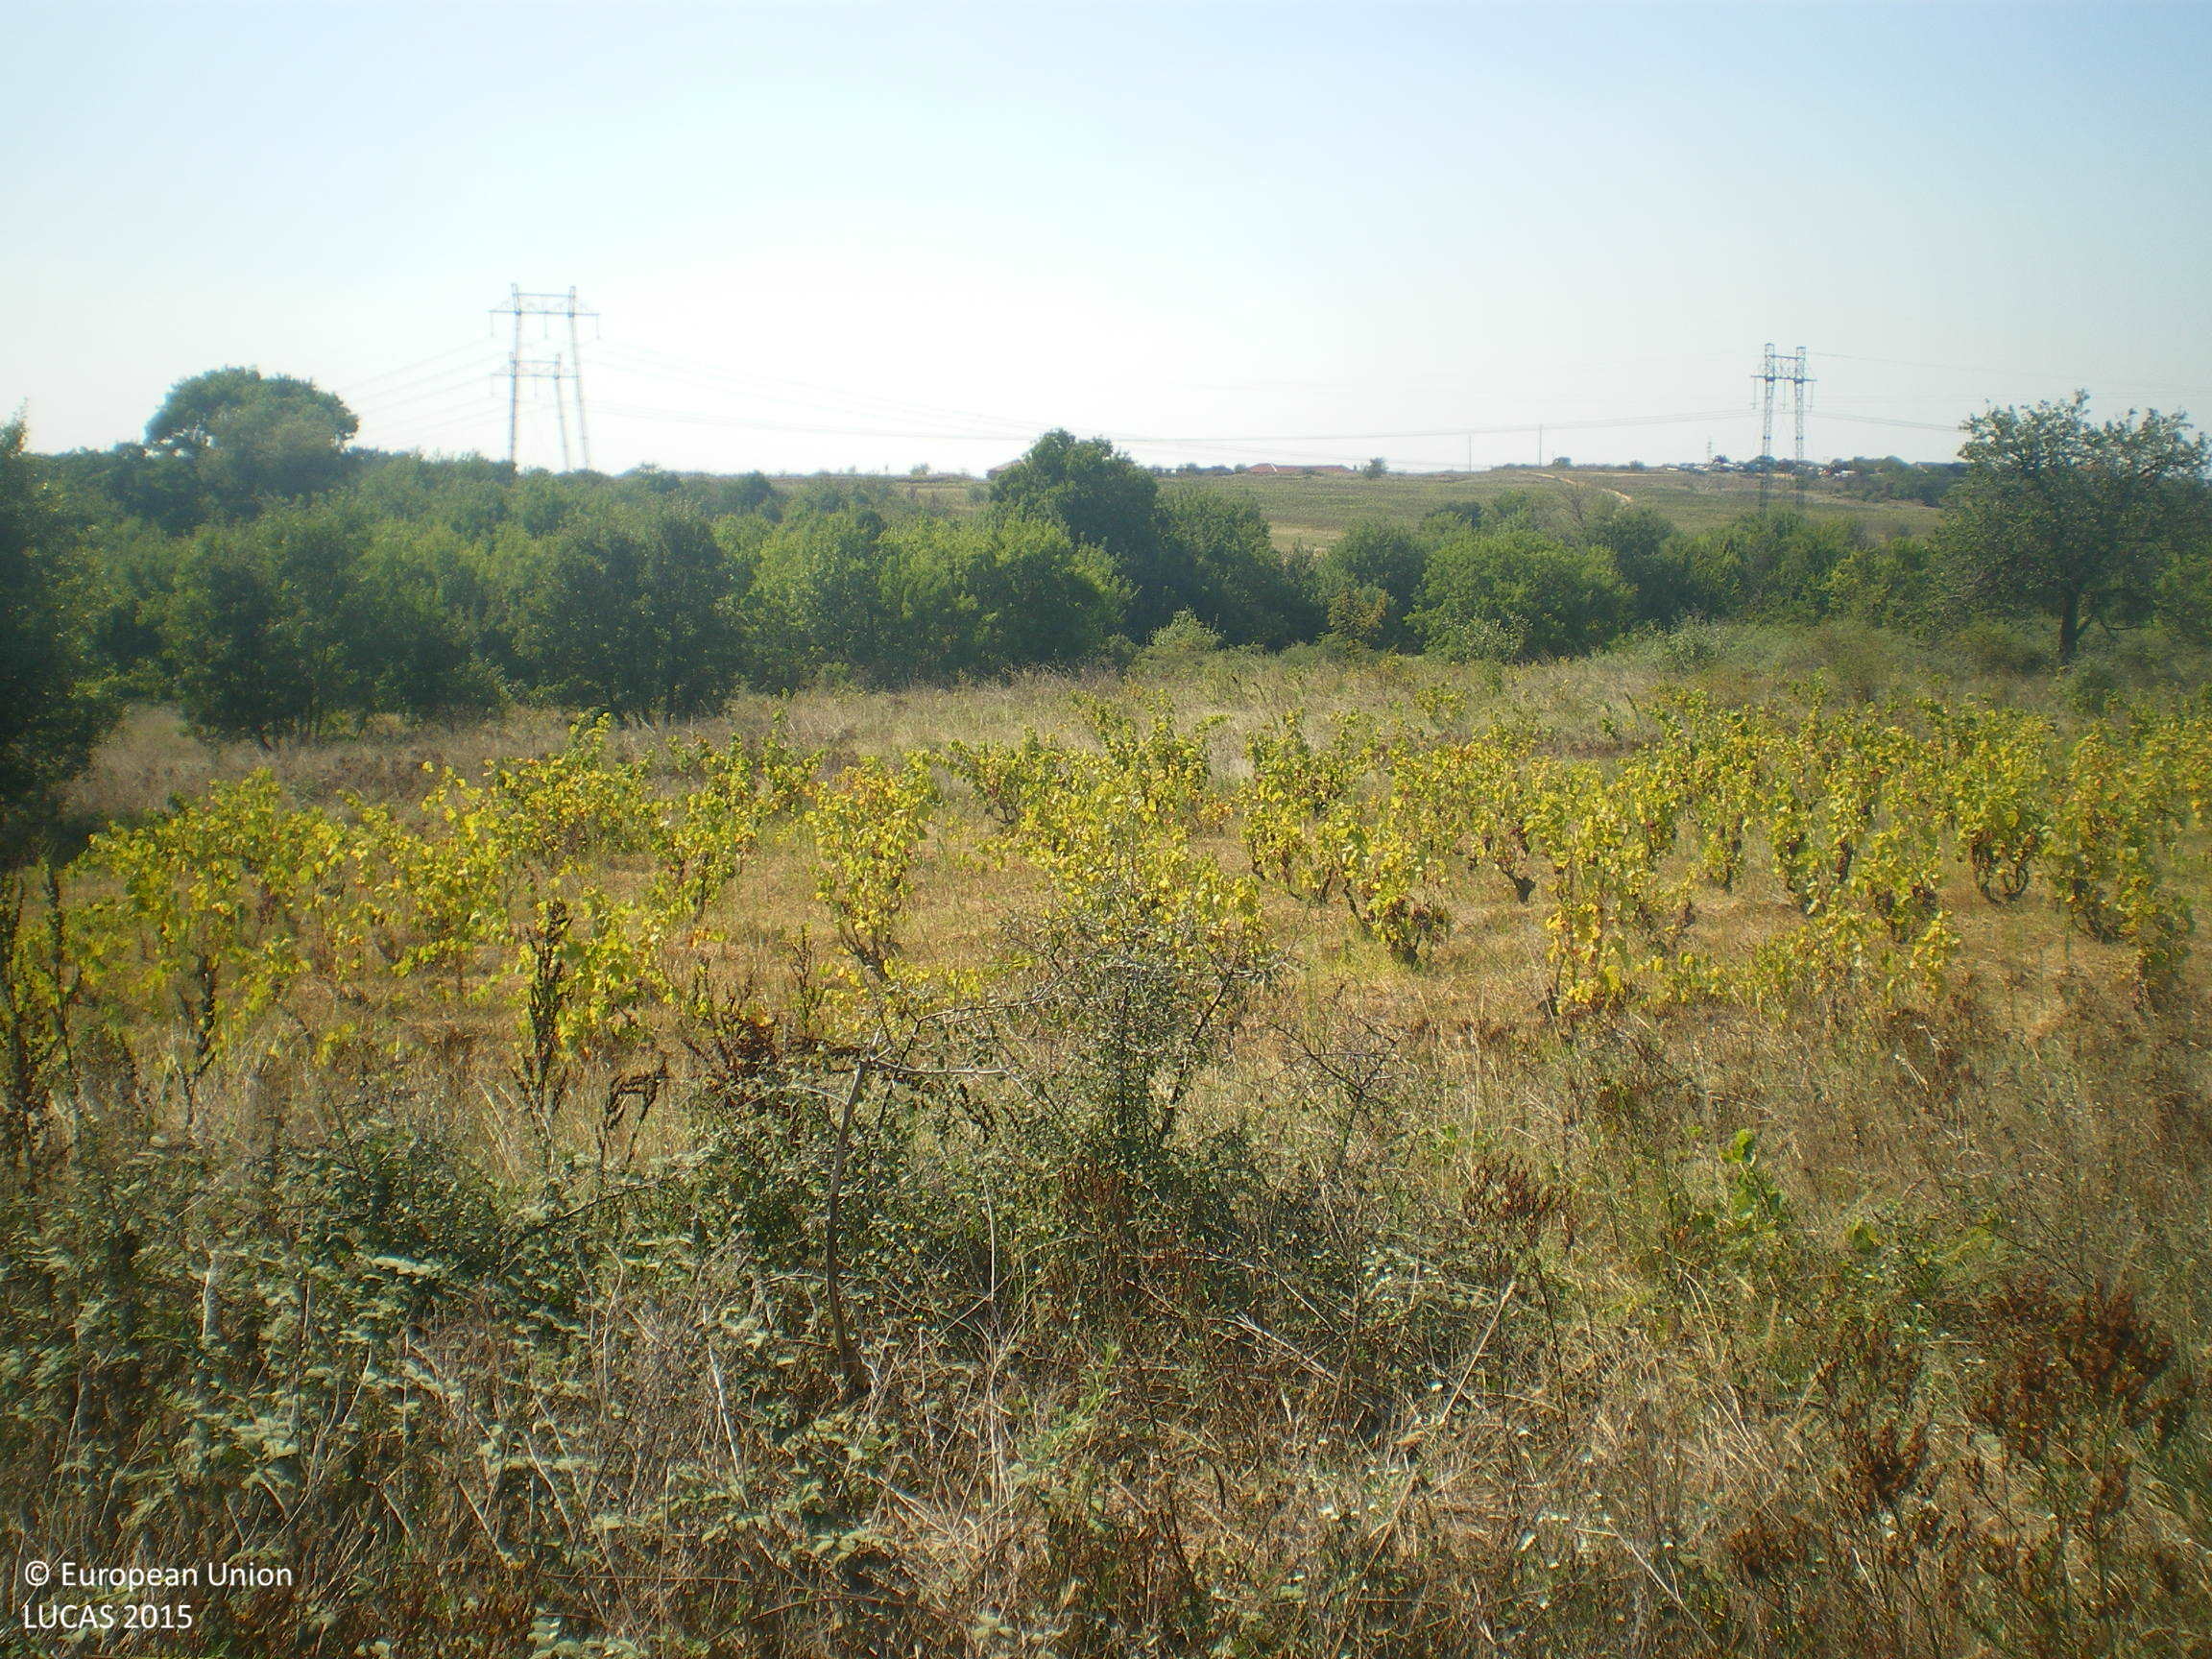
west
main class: Grassland
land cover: Grassland with sparse tree/shrub cover
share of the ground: > 75 %
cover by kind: herbaceous plants 90 %, broadleaved forest trees 5 %, shrubs 5 %
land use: Agriculture (excluding fallow land and kitchen gardens)
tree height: > 5 m
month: August
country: BG
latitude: 42.0428
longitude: 26.0593
